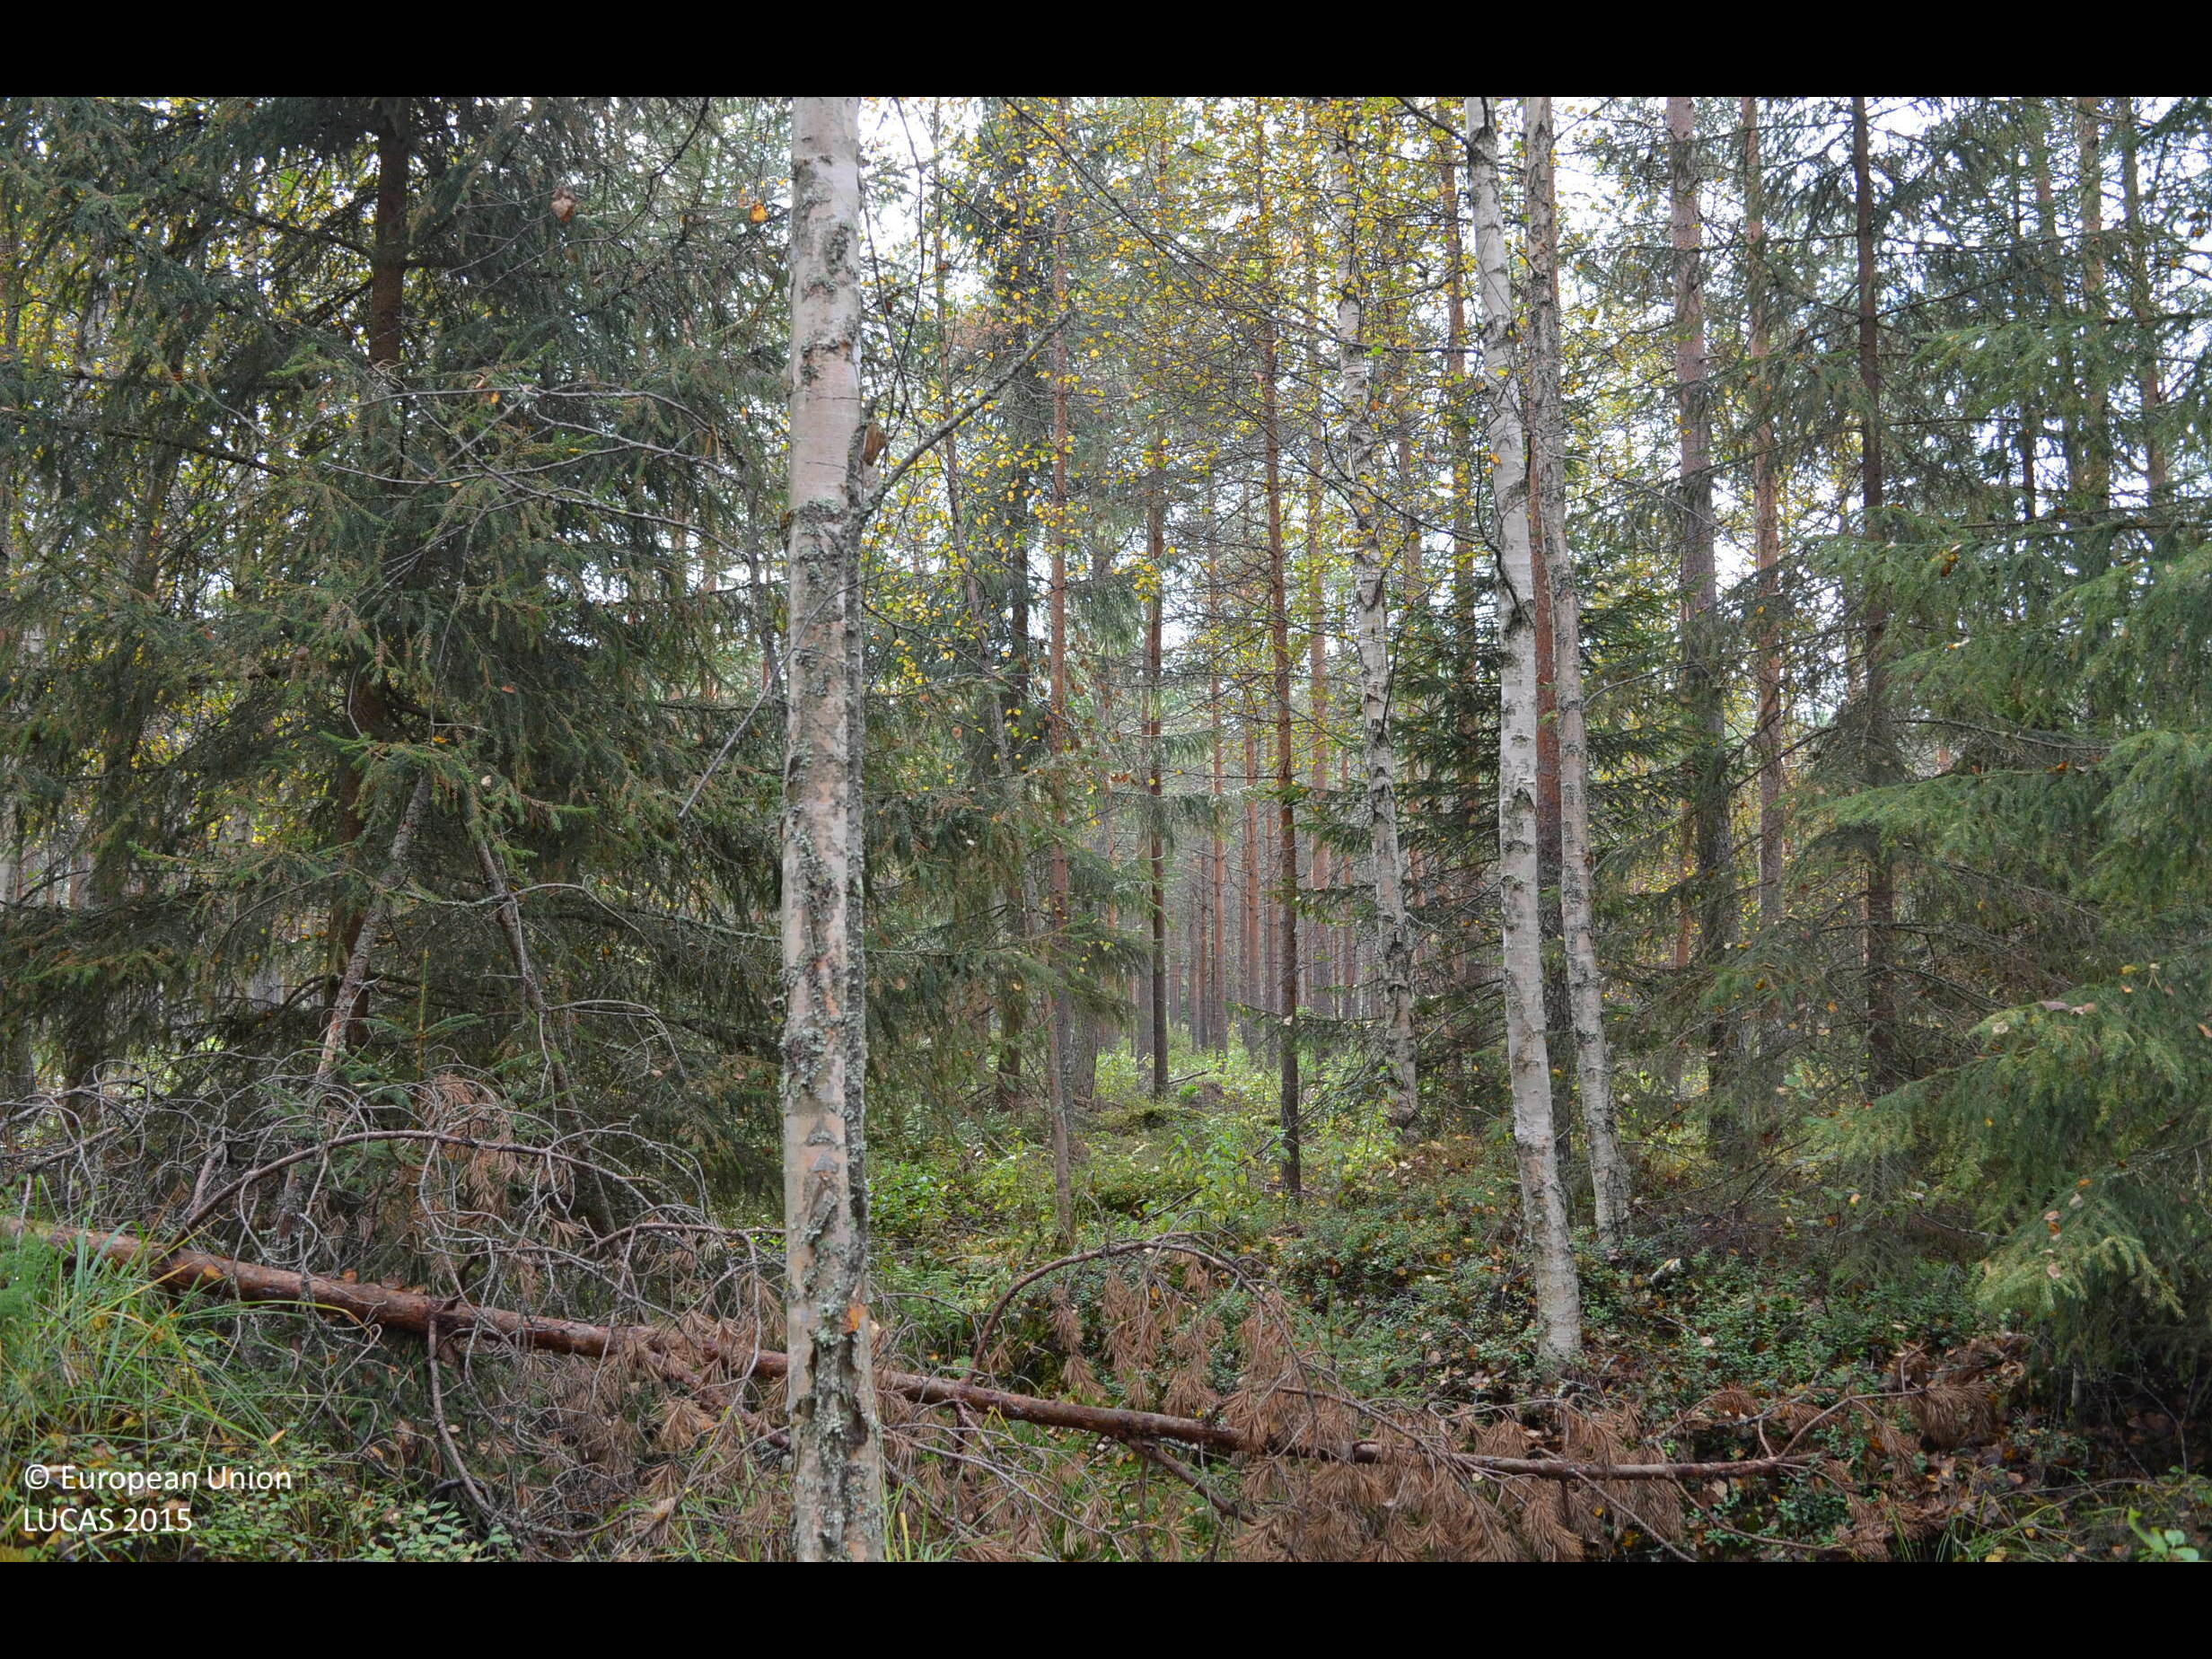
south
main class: Woodland
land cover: Pine dominated mixed woodland
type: boreal forest
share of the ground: > 75 %
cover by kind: coniferous forest trees 55 %, broadleaved forest trees 20 %, herbaceous plants 15 %, shrubs 10 %
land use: Forestry
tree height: > 5 m
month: September
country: FI
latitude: 62.6951
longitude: 23.7320
